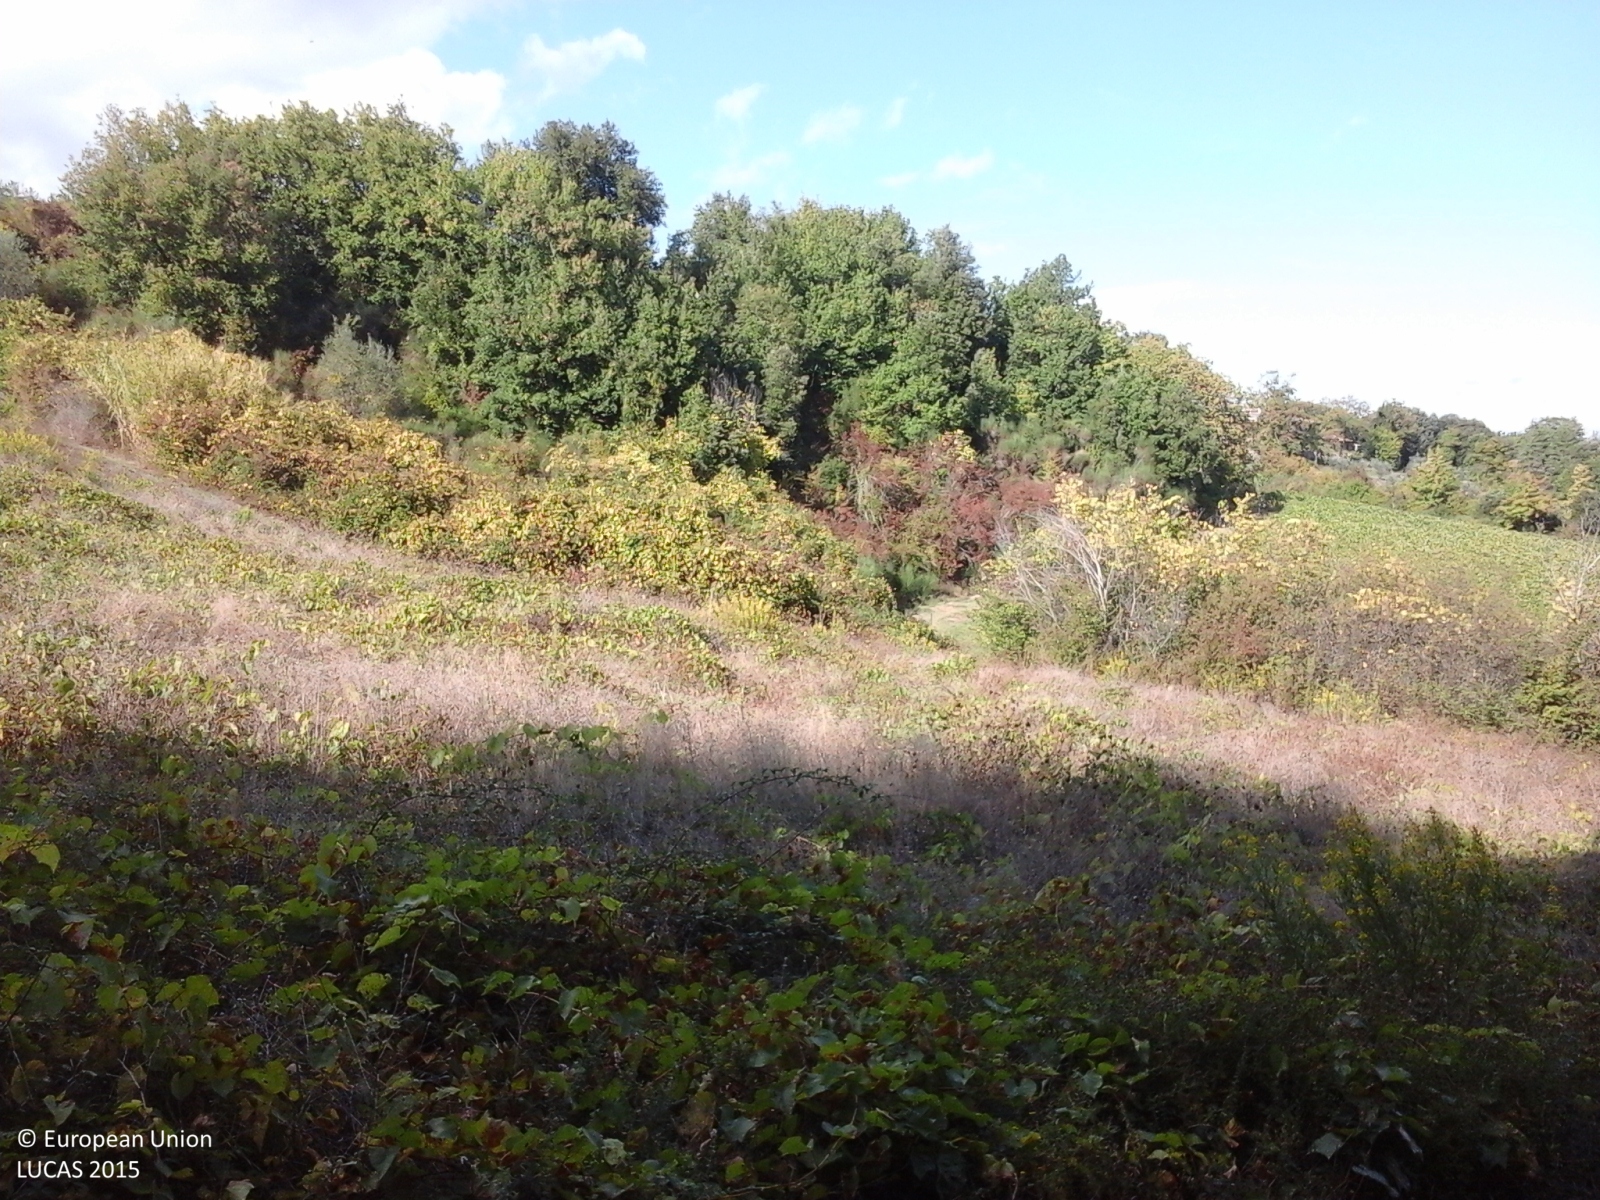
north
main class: Woodland
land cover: Broadleaved woodland
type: mesophytic deciduous forest
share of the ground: > 75 %
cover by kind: broadleaved forest trees 100 %
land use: Forestry
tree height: > 5 m
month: July
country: IT
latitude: 43.4982
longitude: 10.9496
